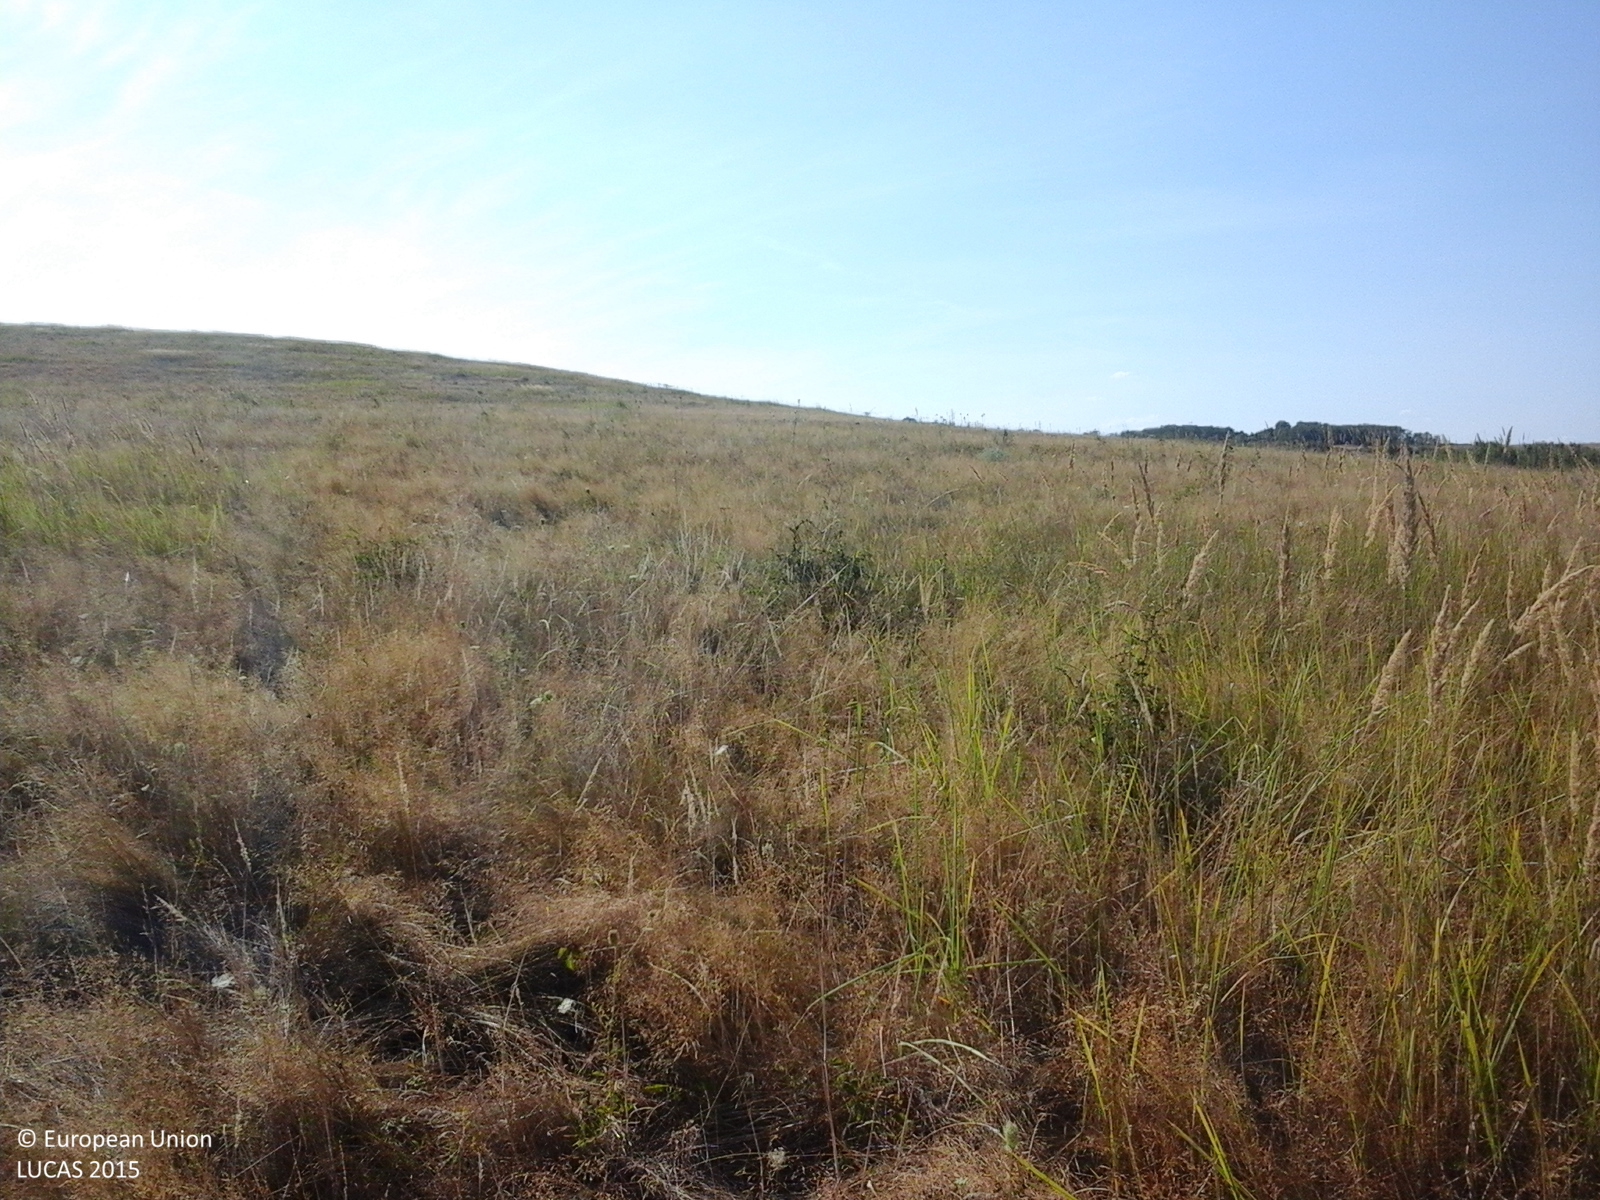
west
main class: Grassland
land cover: Grassland without tree/shrub cover
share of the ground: > 75 %
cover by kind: herbaceous plants 100 %
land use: Agriculture (excluding fallow land and kitchen gardens)
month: August
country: RO
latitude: 45.1423
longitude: 21.5398
